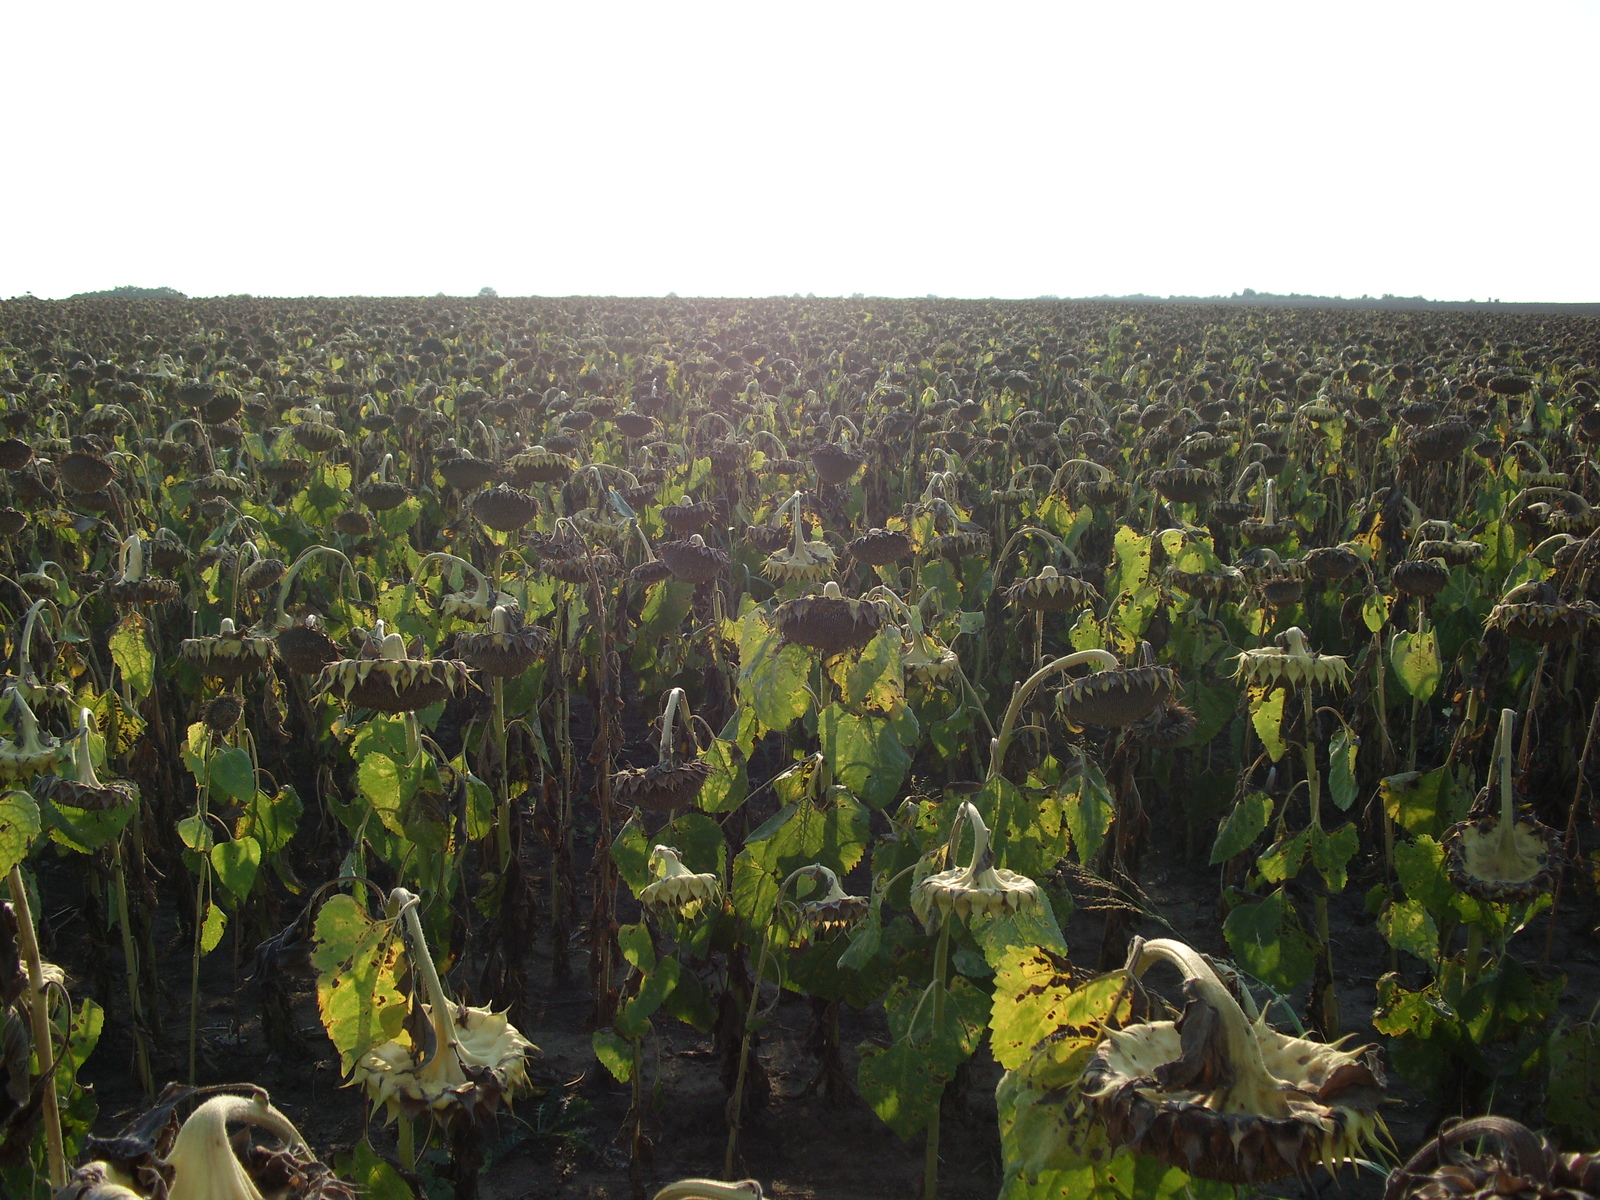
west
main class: Cropland
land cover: Sunflower
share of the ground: > 75 %
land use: Agriculture (excluding fallow land and kitchen gardens)
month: August
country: BG
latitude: 43.7193
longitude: 23.3631
